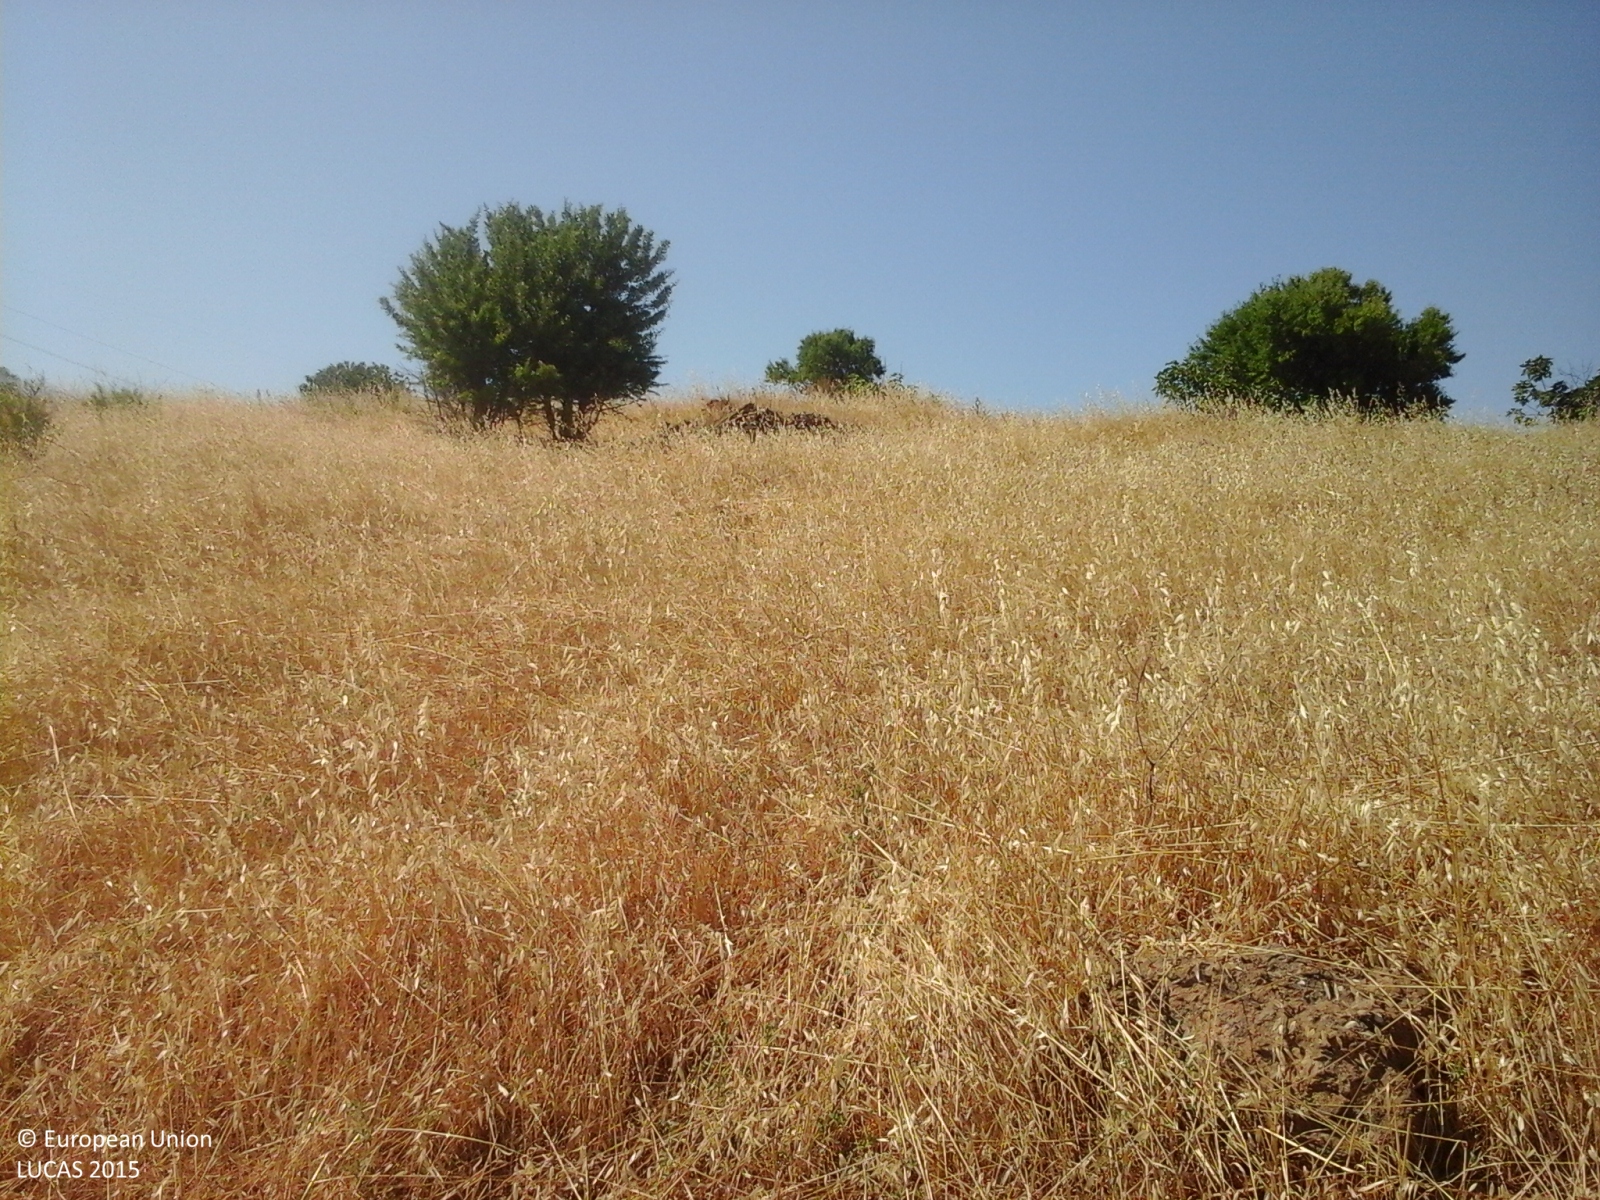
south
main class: Grassland
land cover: Spontaneously vegetated surfaces
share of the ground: > 75 %
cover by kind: herbaceous plants 100 %
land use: Fallow land
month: July
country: IT
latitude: 37.3187
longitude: 13.5270
